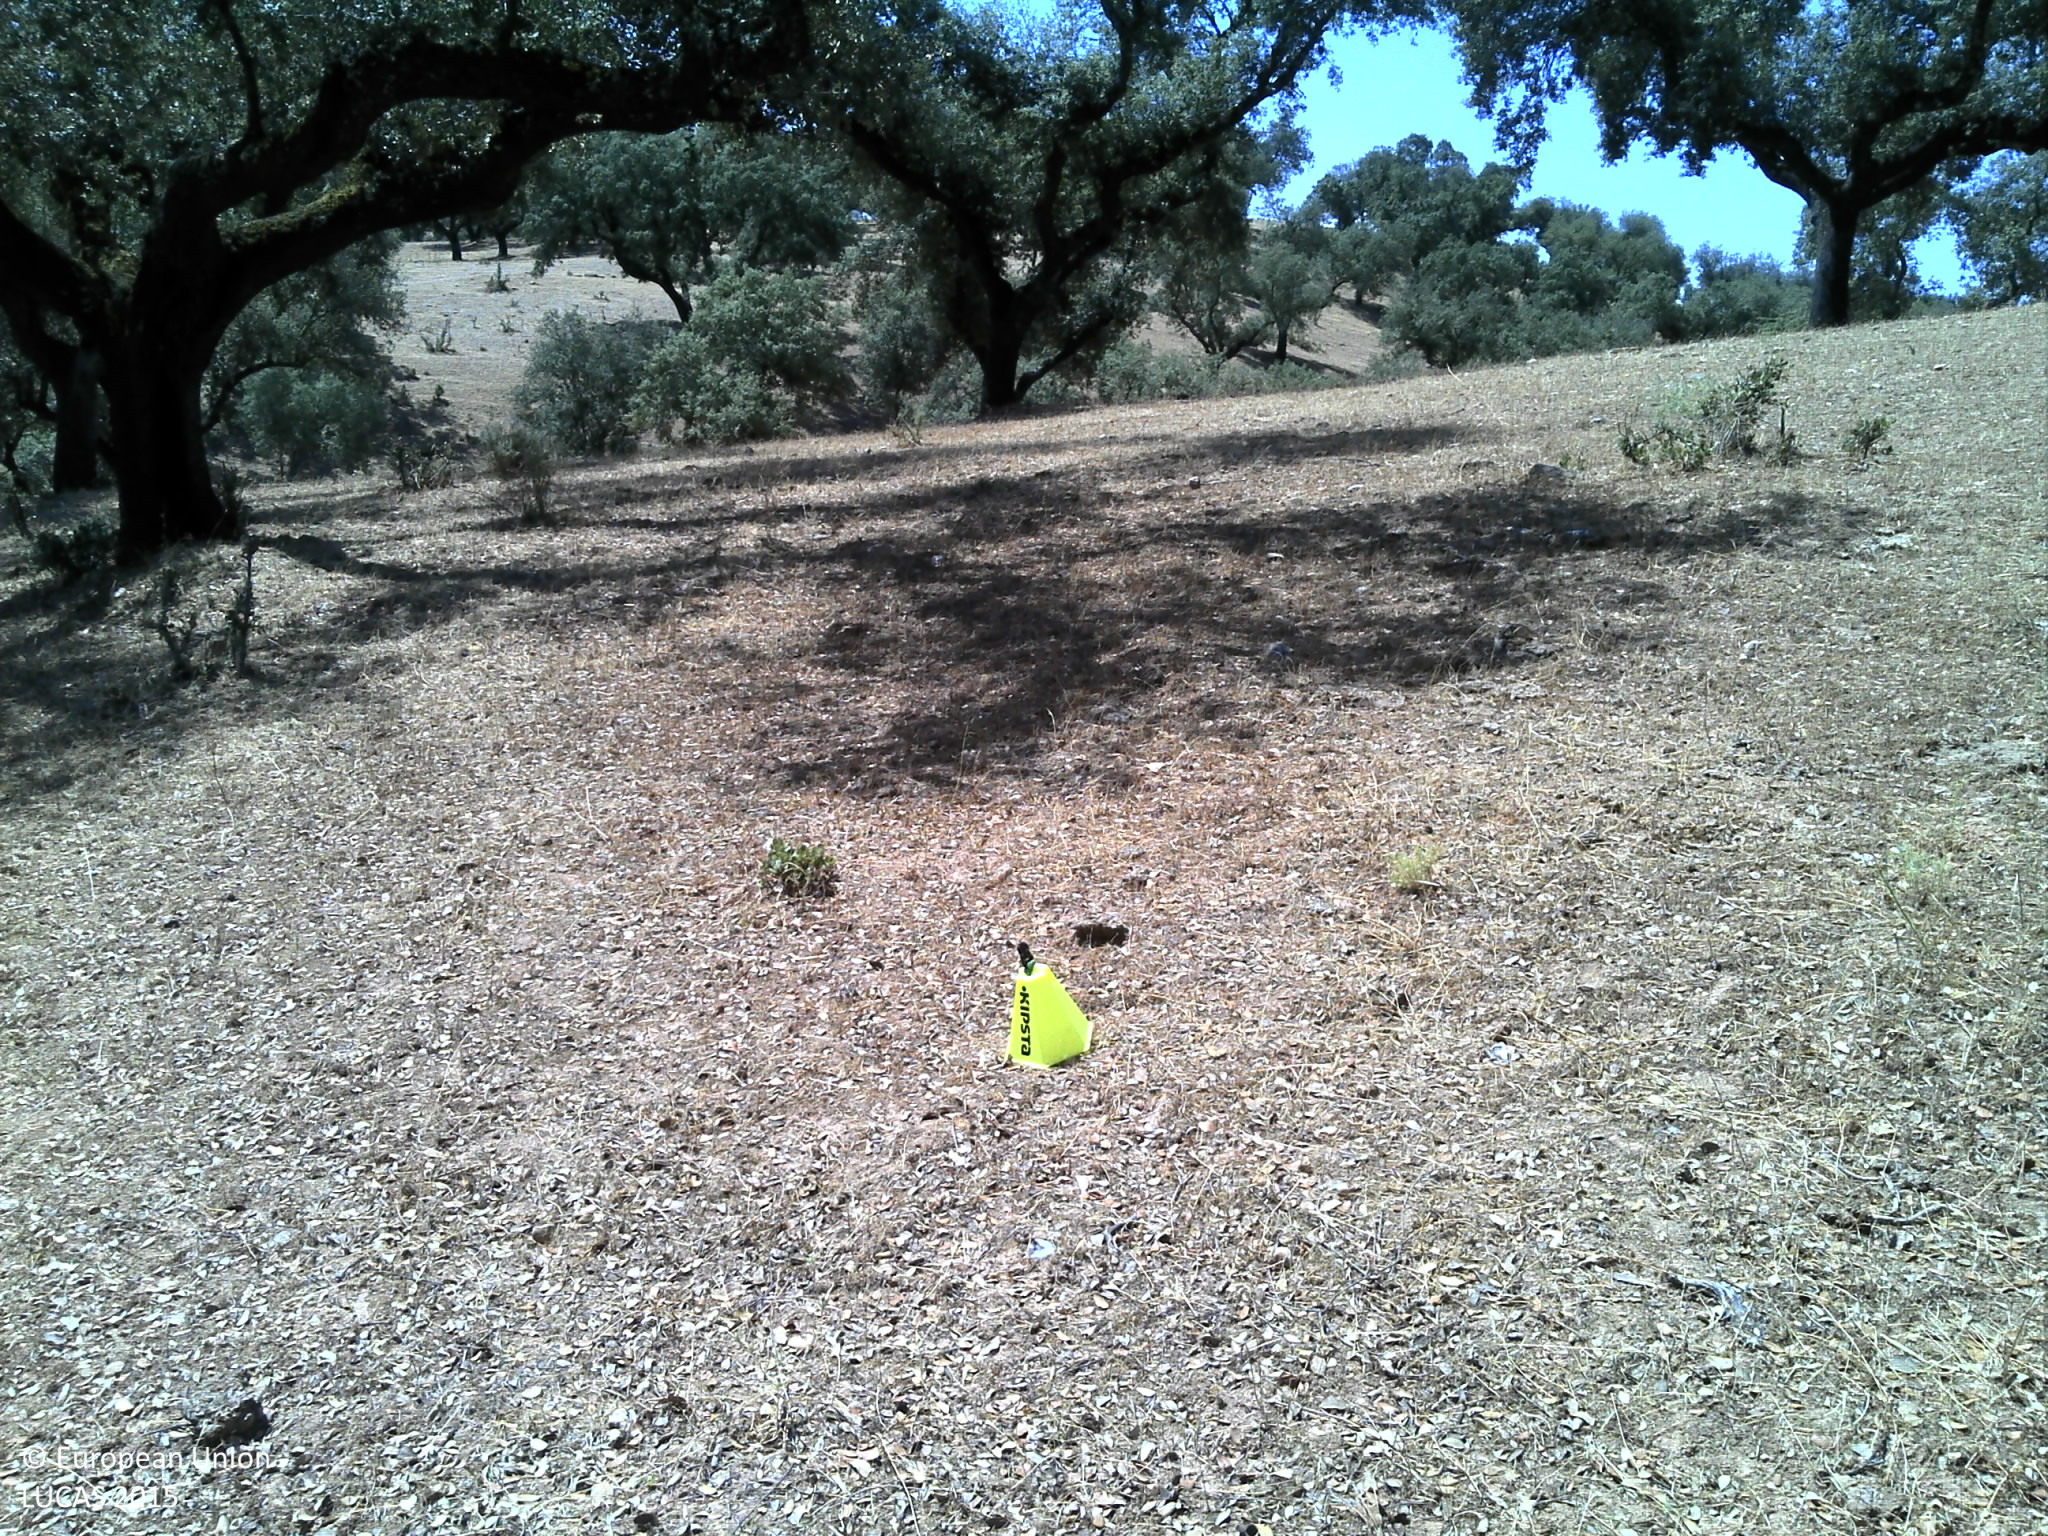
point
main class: Woodland
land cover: Broadleaved woodland
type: broadleaved evergreen forest
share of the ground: 25 - 50 %
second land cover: Grassland without tree/shrub cover
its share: 10 - 25 %
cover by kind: unconsolidated bare surface 55 %, broadleaved forest trees 30 %, herbaceous plants 15 %
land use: Forestry
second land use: Agriculture (excluding fallow land and kitchen gardens)
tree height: > 5 m
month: July
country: PT
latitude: 38.4953
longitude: -7.7017
